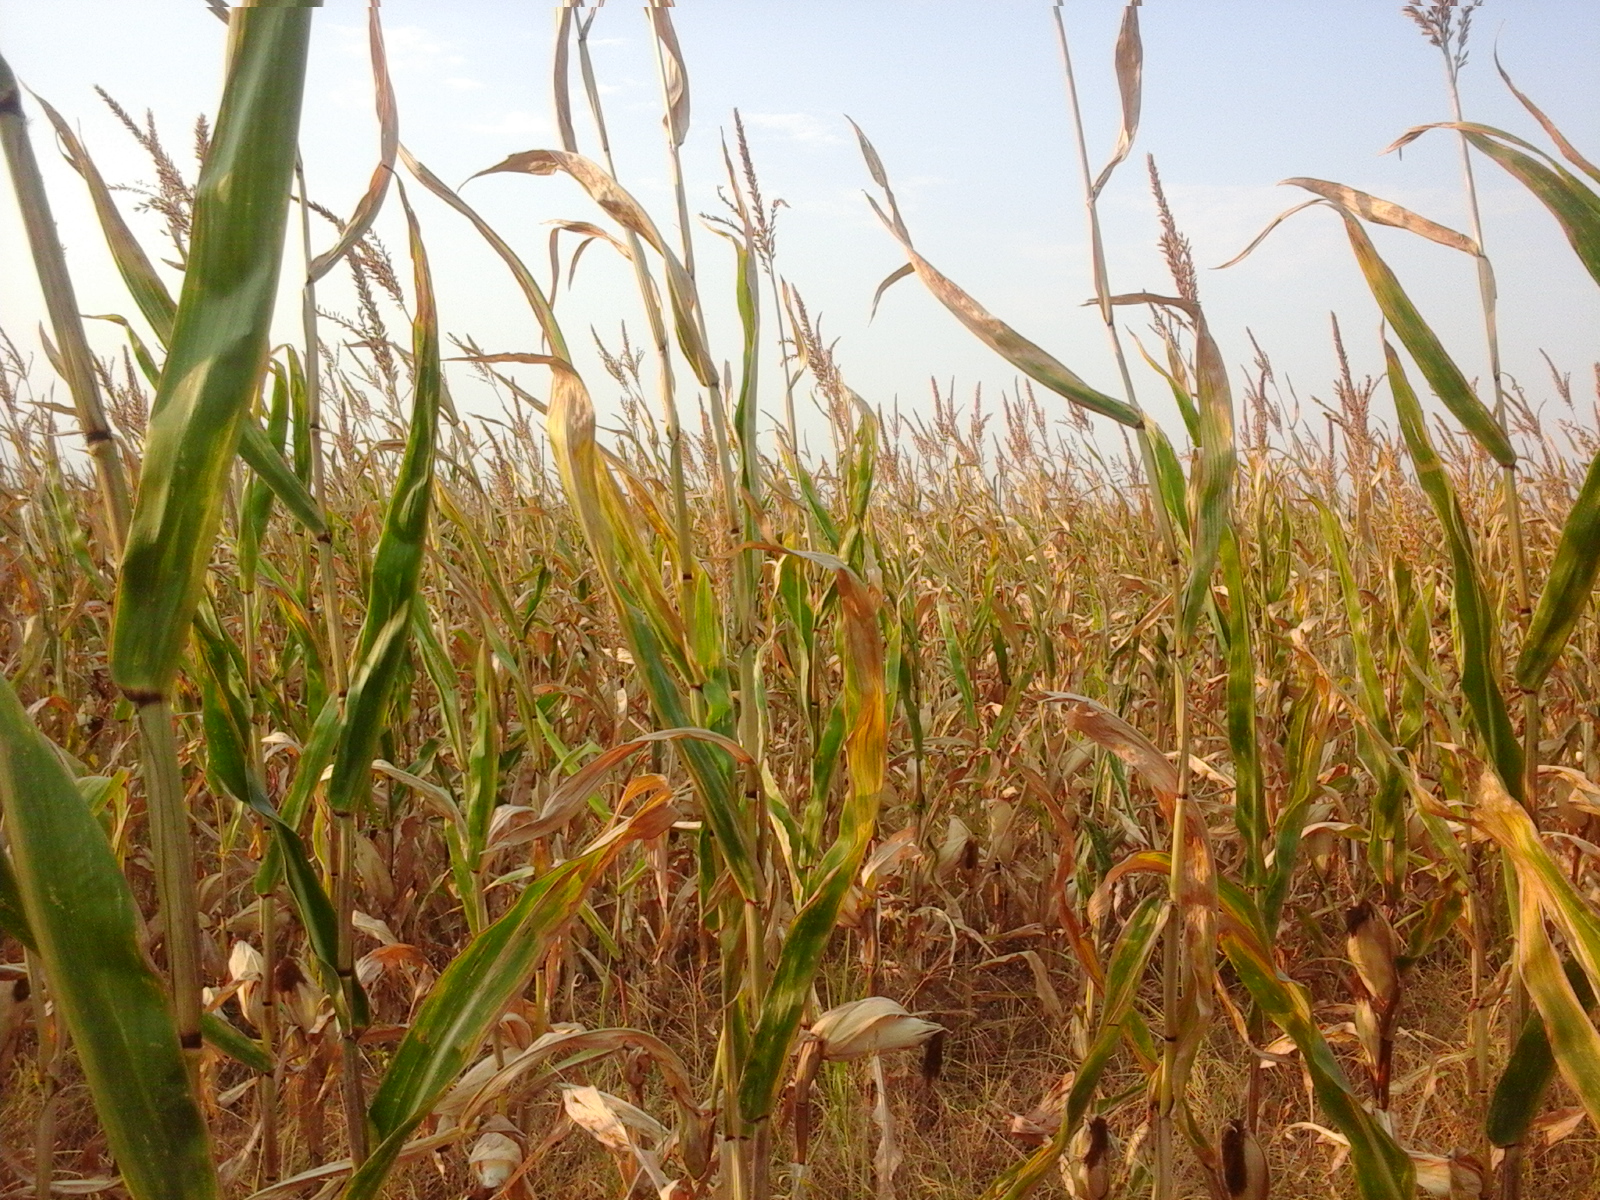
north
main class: Cropland
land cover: Maize
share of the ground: > 75 %
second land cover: Spontaneously vegetated surfaces
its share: > 75 %
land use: Agriculture (excluding fallow land and kitchen gardens)
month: August
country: RO
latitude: 44.0574
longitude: 23.2907
